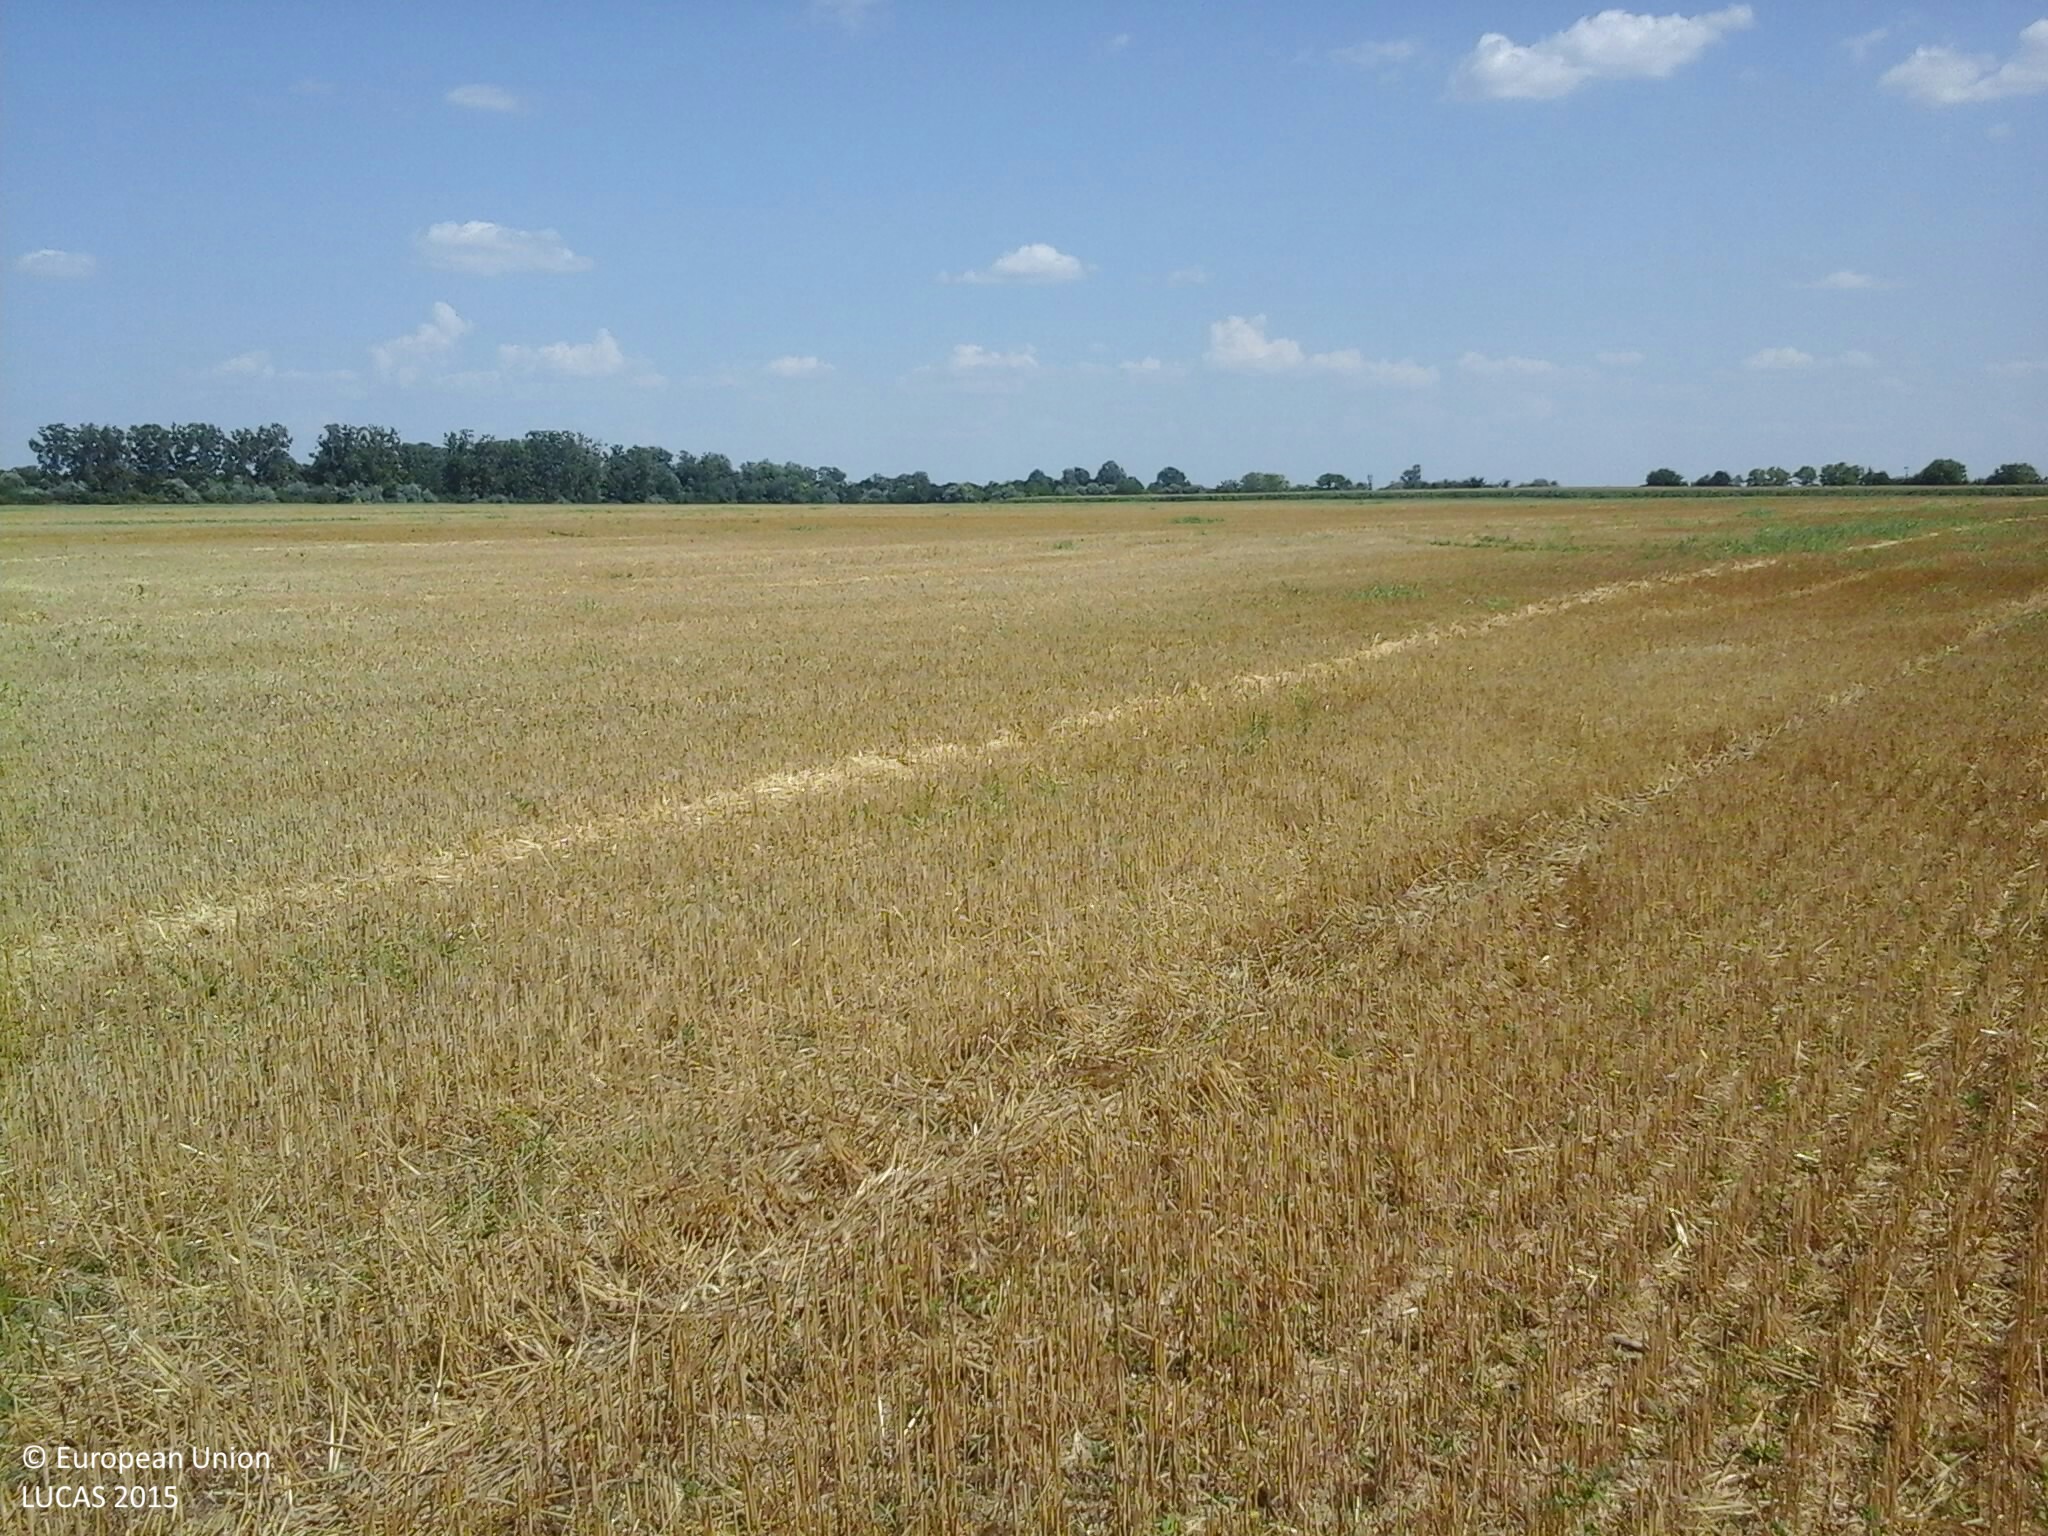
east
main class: Cropland
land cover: Common wheat
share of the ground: 25 - 50 %
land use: Agriculture (excluding fallow land and kitchen gardens)
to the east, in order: Common wheat
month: July
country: HU
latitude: 47.0406
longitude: 18.3158
